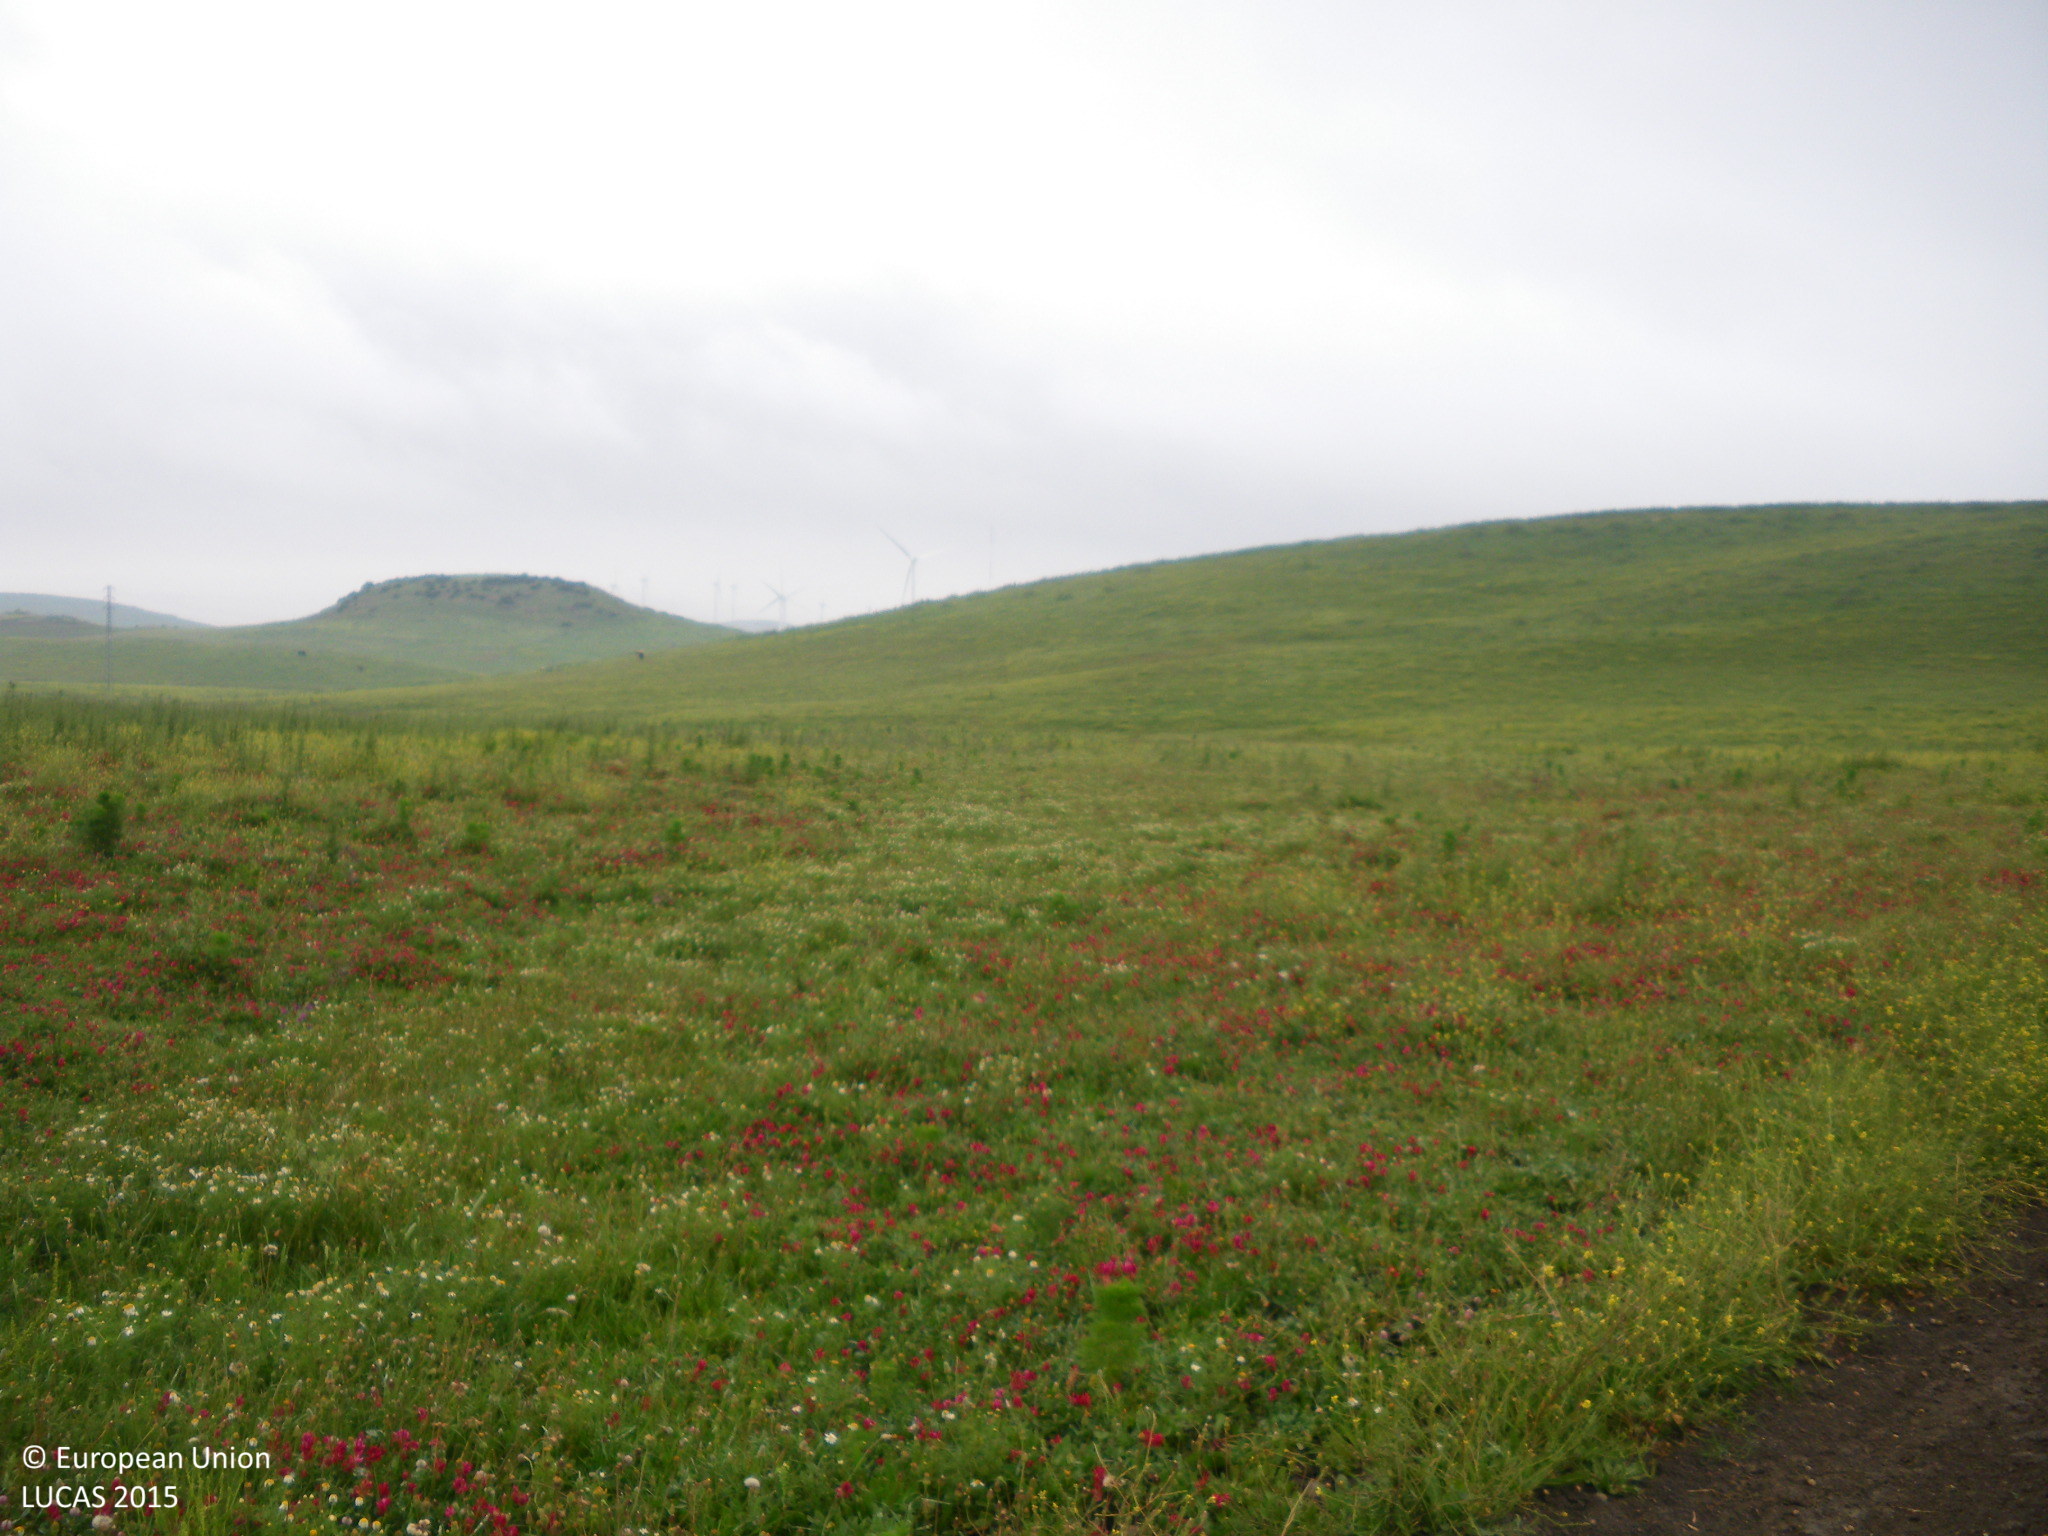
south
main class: Grassland
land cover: Grassland without tree/shrub cover
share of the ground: > 75 %
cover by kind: herbaceous plants 95 %, unconsolidated bare surface 5 %
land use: Agriculture (excluding fallow land and kitchen gardens)
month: April
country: ES
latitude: 36.5159
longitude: -5.8725
